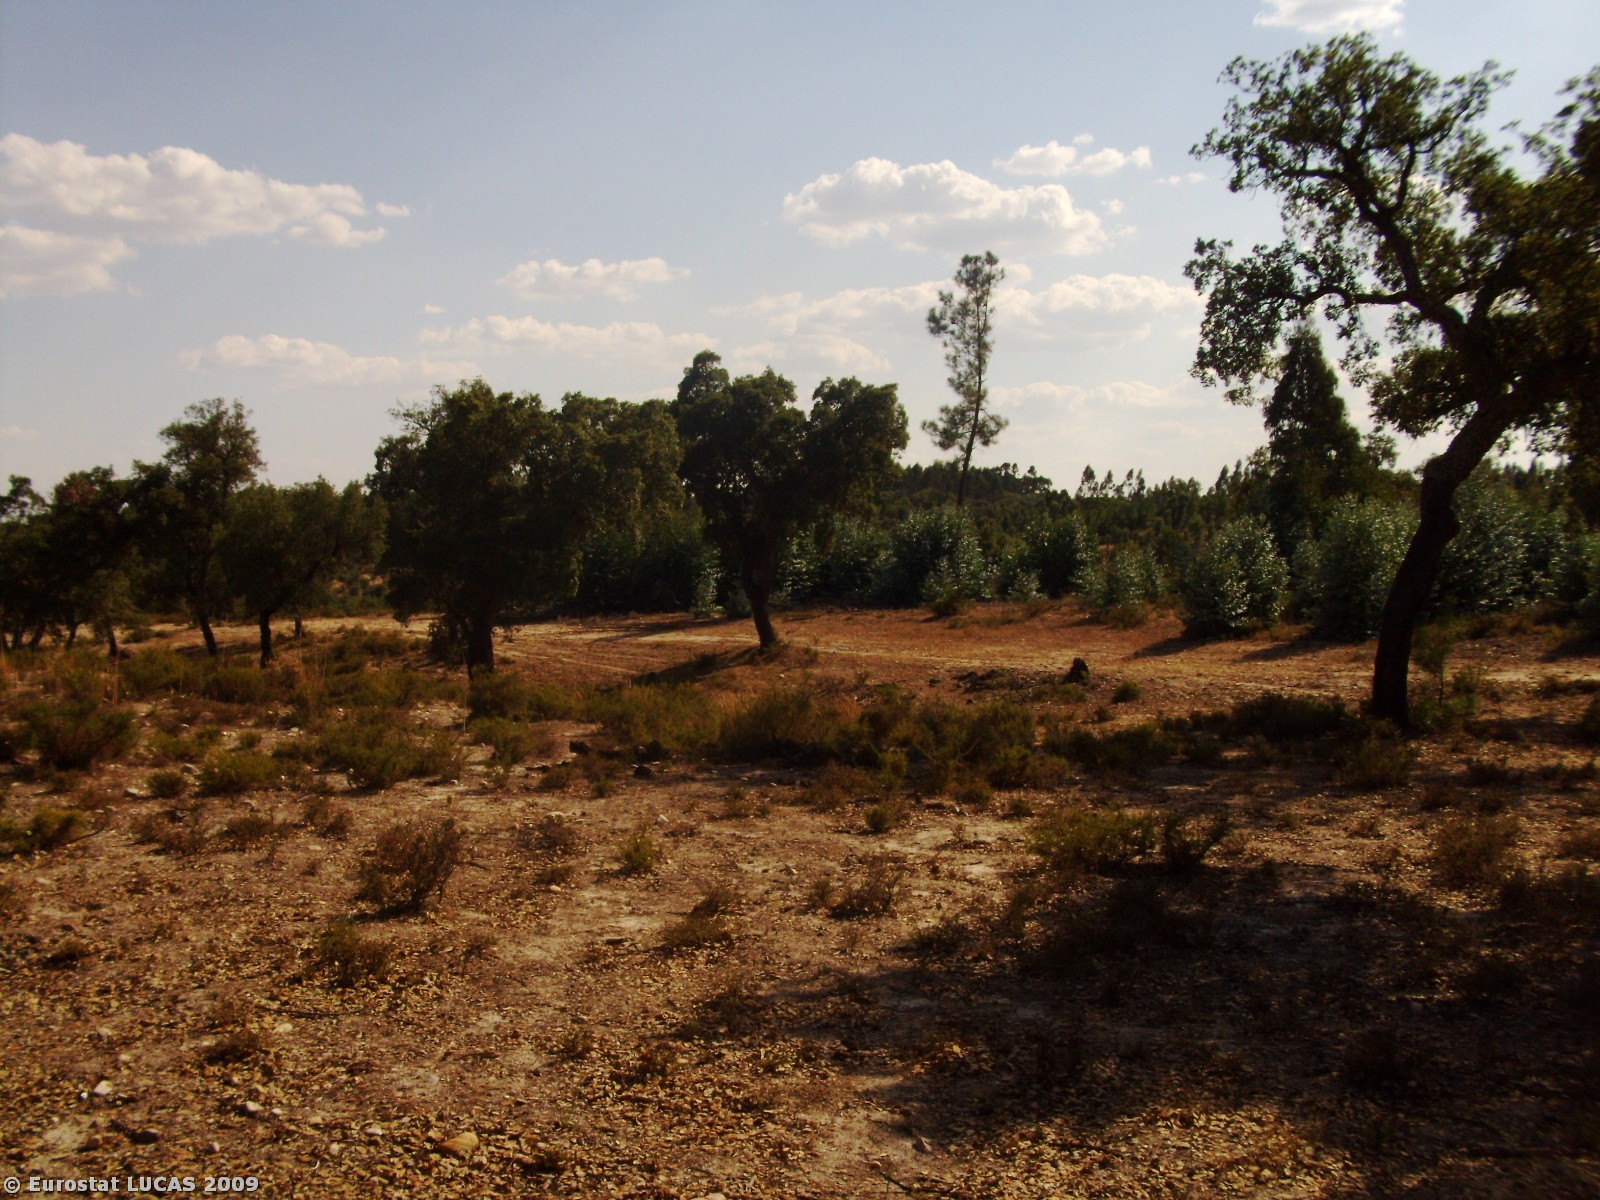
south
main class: Woodland
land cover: Broadleaved woodland
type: broadleaved evergreen forest
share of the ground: > 75 %
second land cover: Spontaneously vegetated surfaces
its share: 10 - 25 %
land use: Forestry
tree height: > 5 m
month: August
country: PT
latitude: 39.3218
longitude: -8.0240
